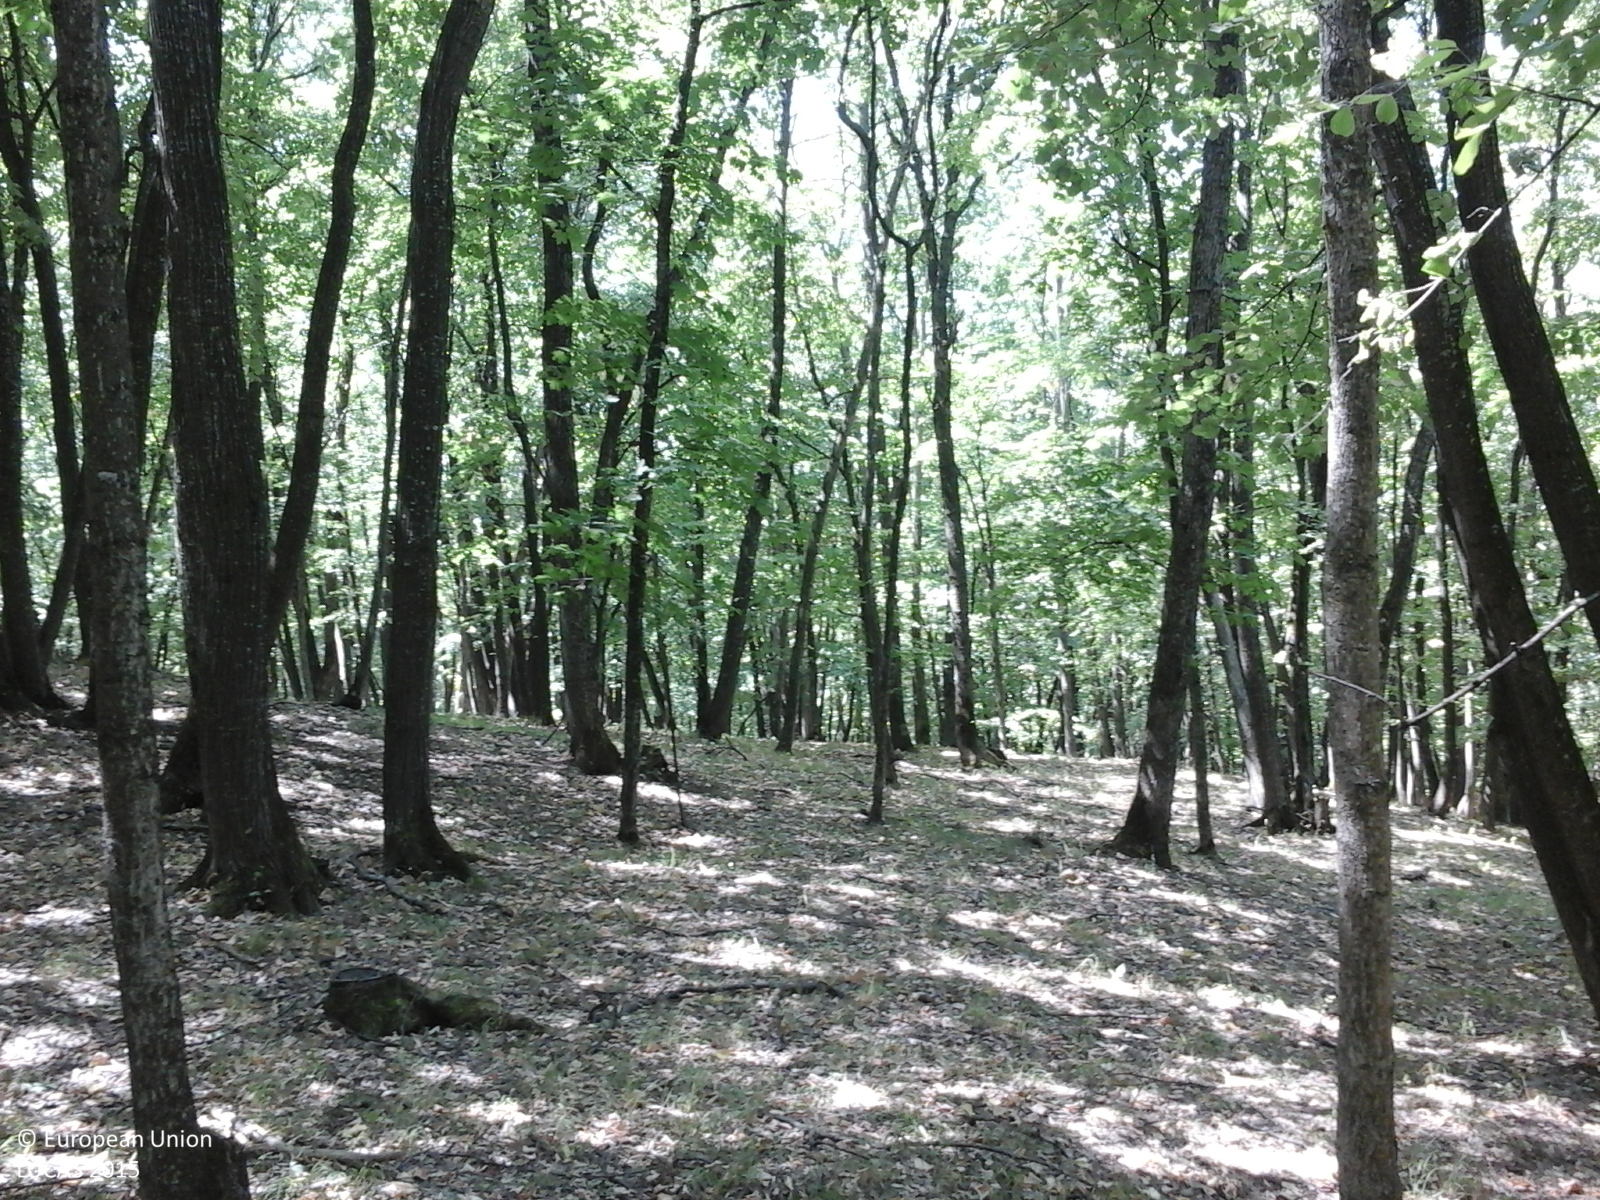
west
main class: Woodland
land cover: Broadleaved woodland
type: beech forest
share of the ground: > 75 %
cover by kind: broadleaved forest trees 100 %
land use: Forestry
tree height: > 5 m
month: July
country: RO
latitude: 46.2802
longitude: 27.2454
